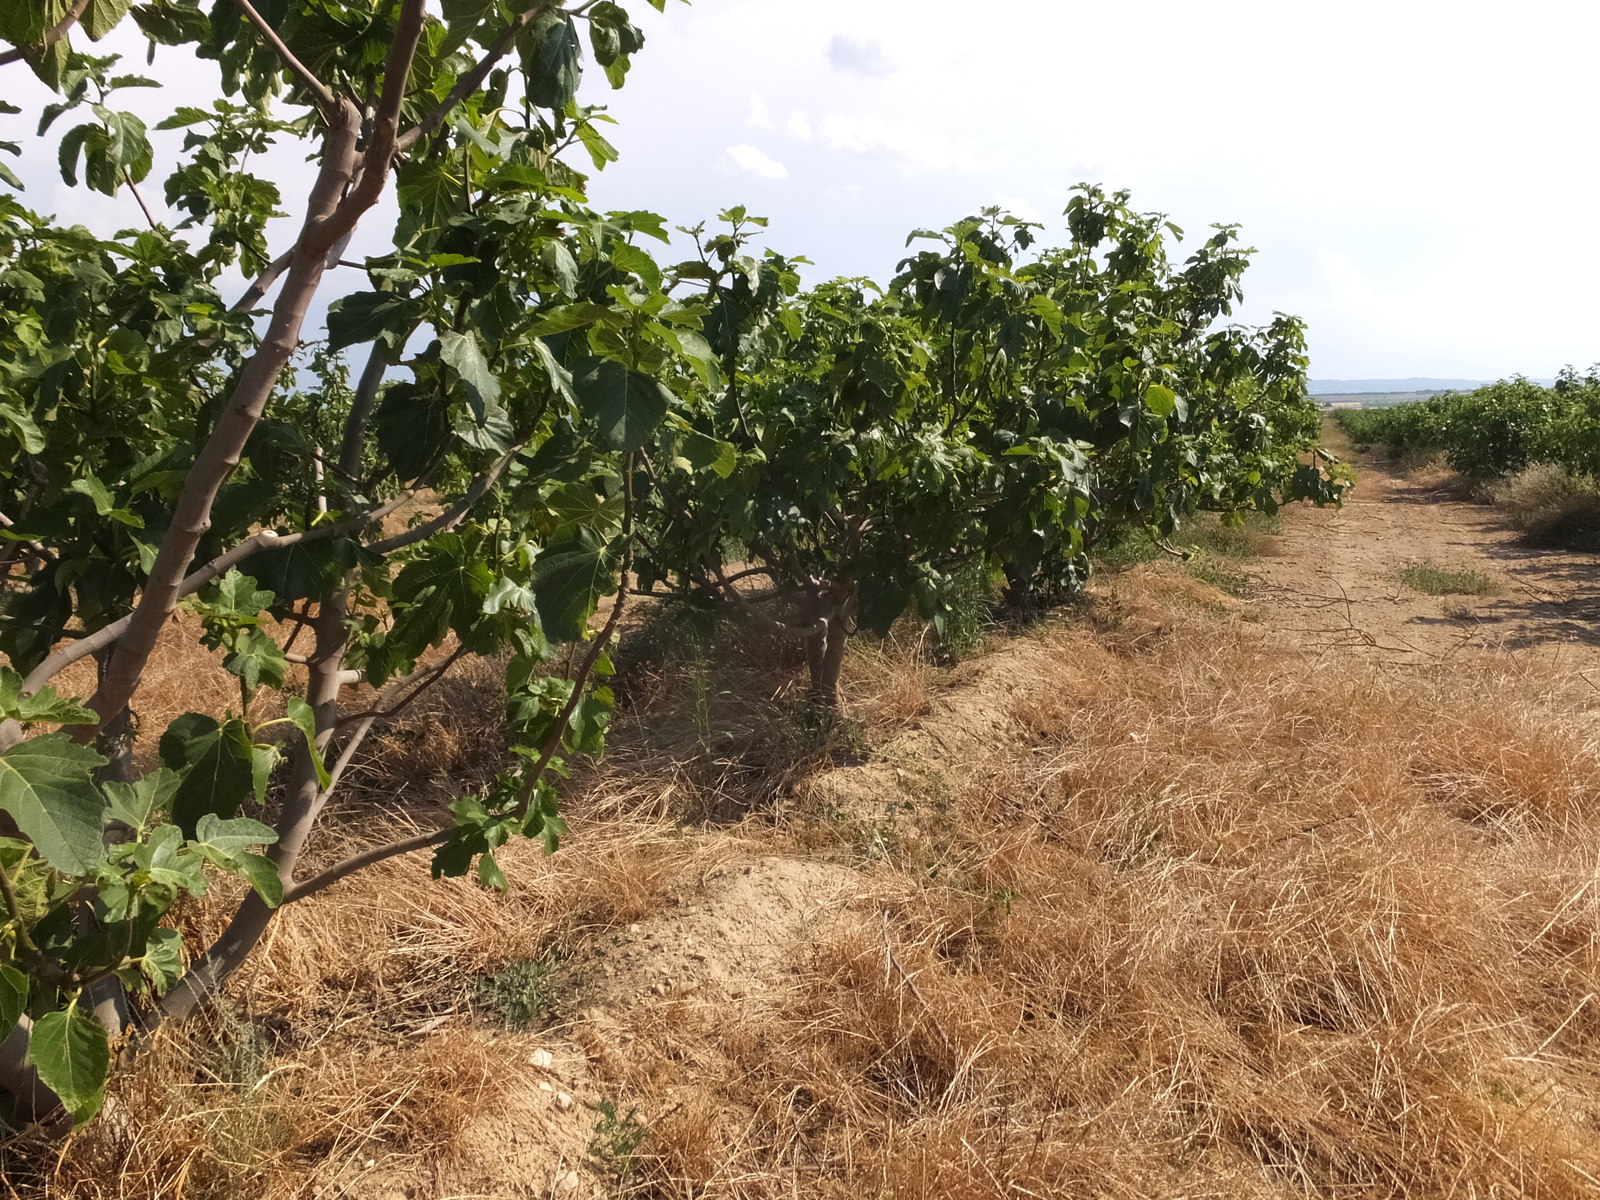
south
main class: Cropland
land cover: Other fruit trees and berries
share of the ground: > 75 %
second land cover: Spontaneously vegetated surfaces
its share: 10 - 25 %
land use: Agriculture (excluding fallow land and kitchen gardens)
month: June
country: ES
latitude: 41.7996
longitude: 0.0543
